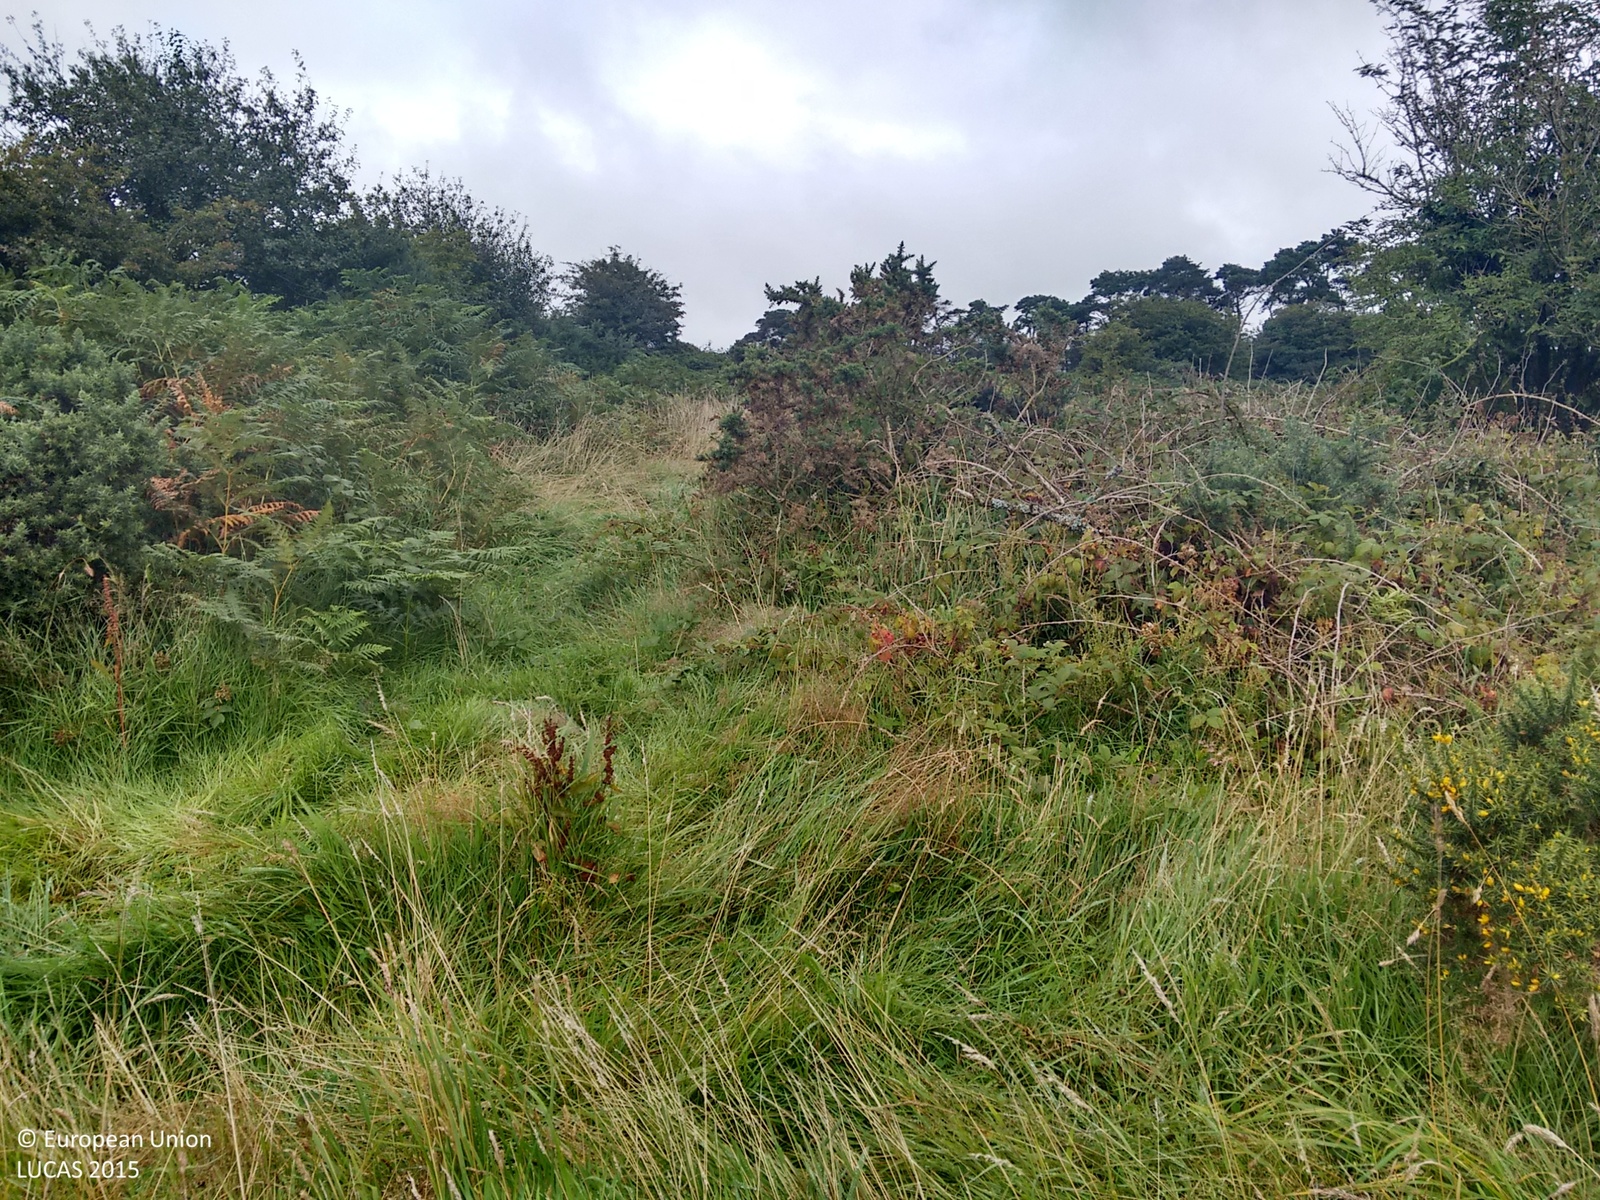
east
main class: Shrubland
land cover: Shrubland with sparse tree cover
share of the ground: > 75 %
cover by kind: herbaceous plants 65 %, shrubs 30 %, broadleaved forest trees 5 %
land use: Agriculture (excluding fallow land and kitchen gardens)
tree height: < 5 m
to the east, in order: Shrubland with sparse tree cover; Broadleaved woodland; Fences; Grassland without tree/shrub cover; Shruby margins; Abandoned hedges; Shruby margins; Grassland without tree/shrub cover
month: August
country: GB
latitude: 51.7625
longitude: -4.7302
